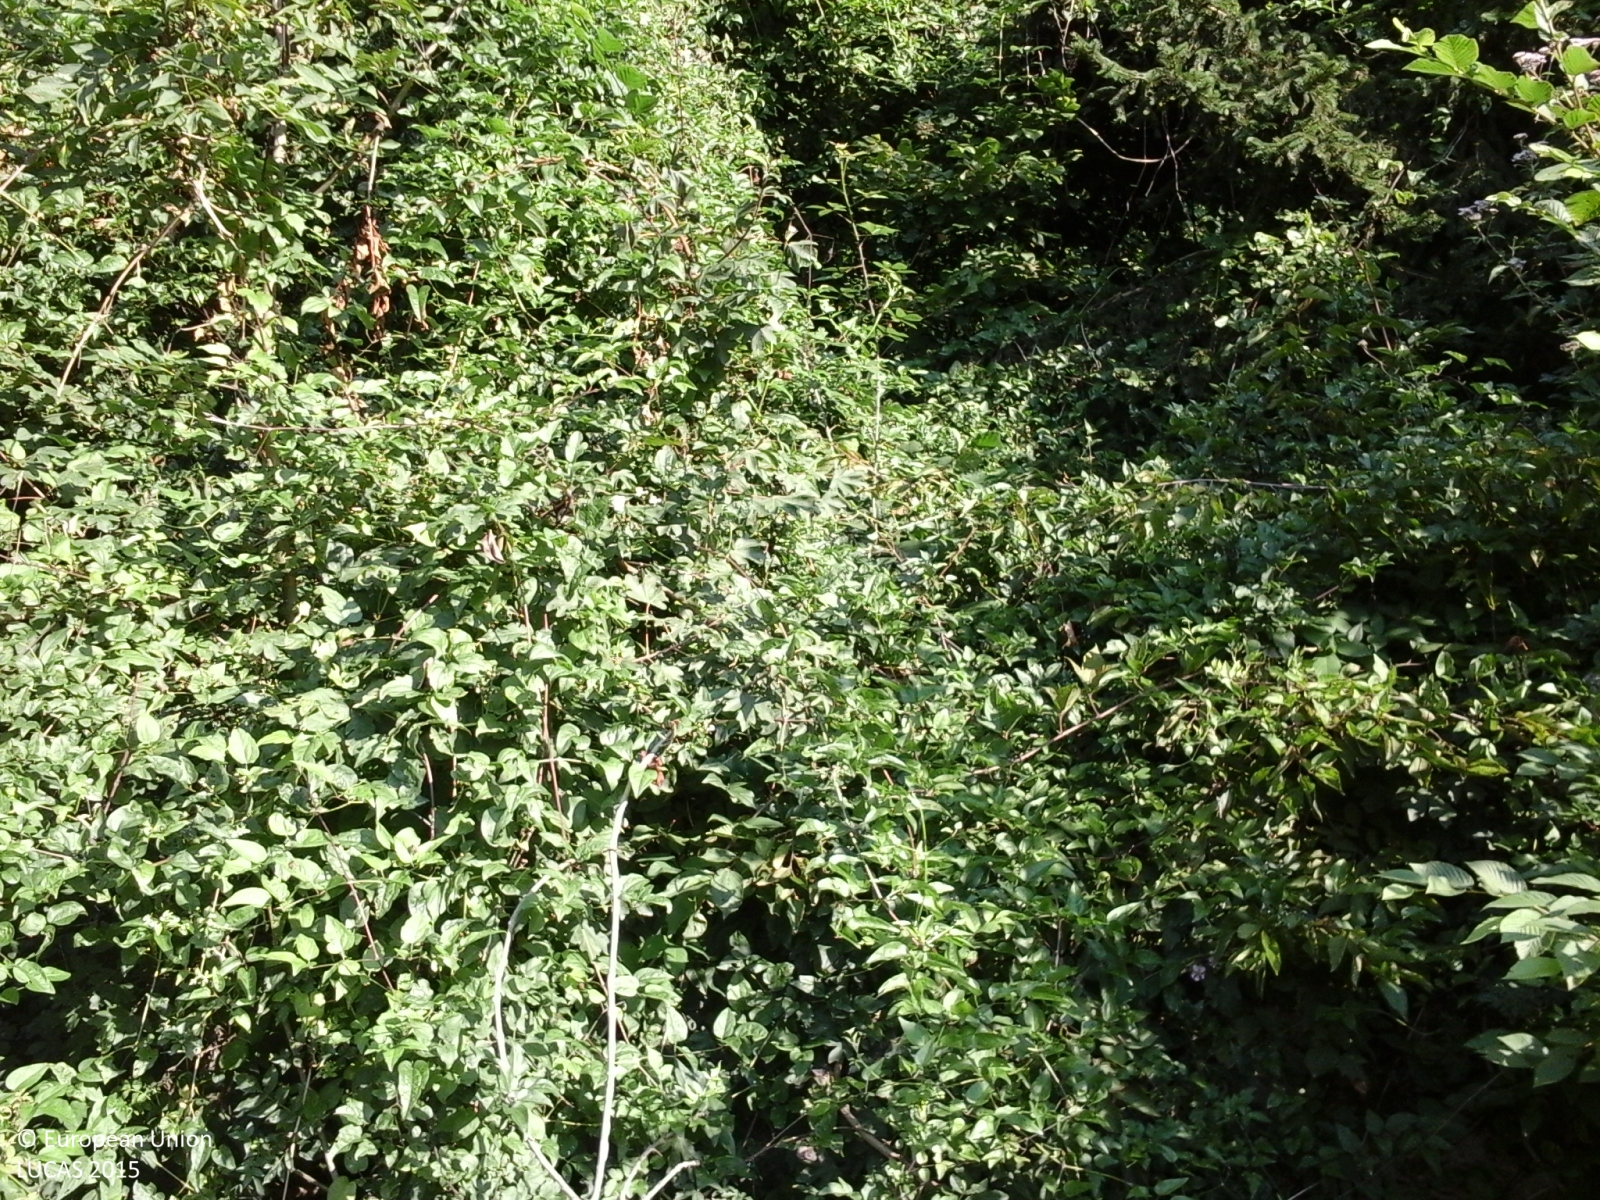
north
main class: Woodland
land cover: Broadleaved woodland
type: thermophilous deciduous forest
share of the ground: > 75 %
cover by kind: broadleaved forest trees 90 %, shrubs 10 %
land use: Forestry
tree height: > 5 m
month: August
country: IT
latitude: 44.1697
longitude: 8.0410
